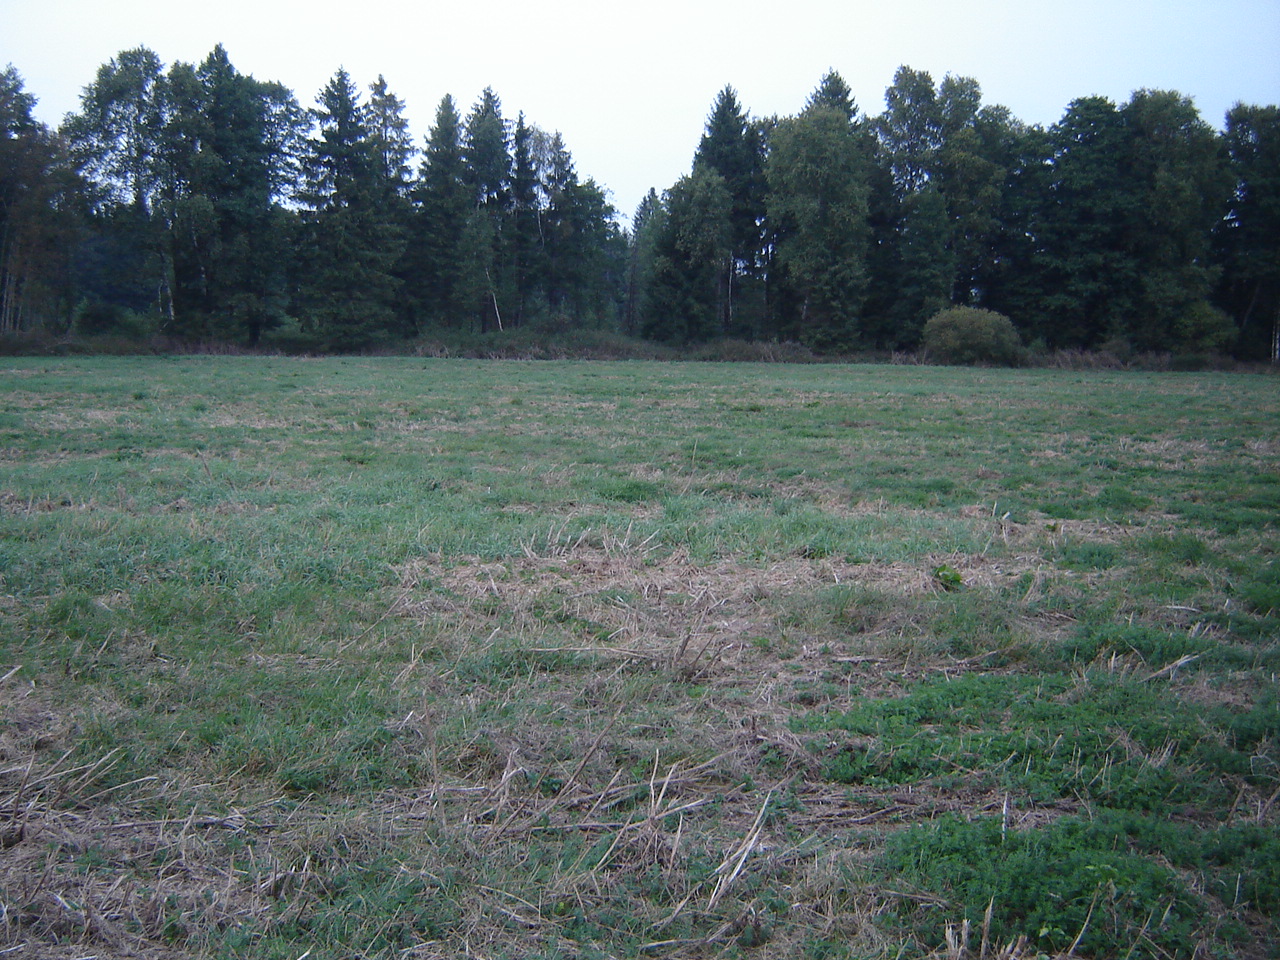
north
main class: Grassland
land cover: Grassland without tree/shrub cover
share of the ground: > 75 %
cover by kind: herbaceous plants 100 %
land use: Agriculture (excluding fallow land and kitchen gardens)
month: September
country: LT
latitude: 54.4218
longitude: 24.8293
